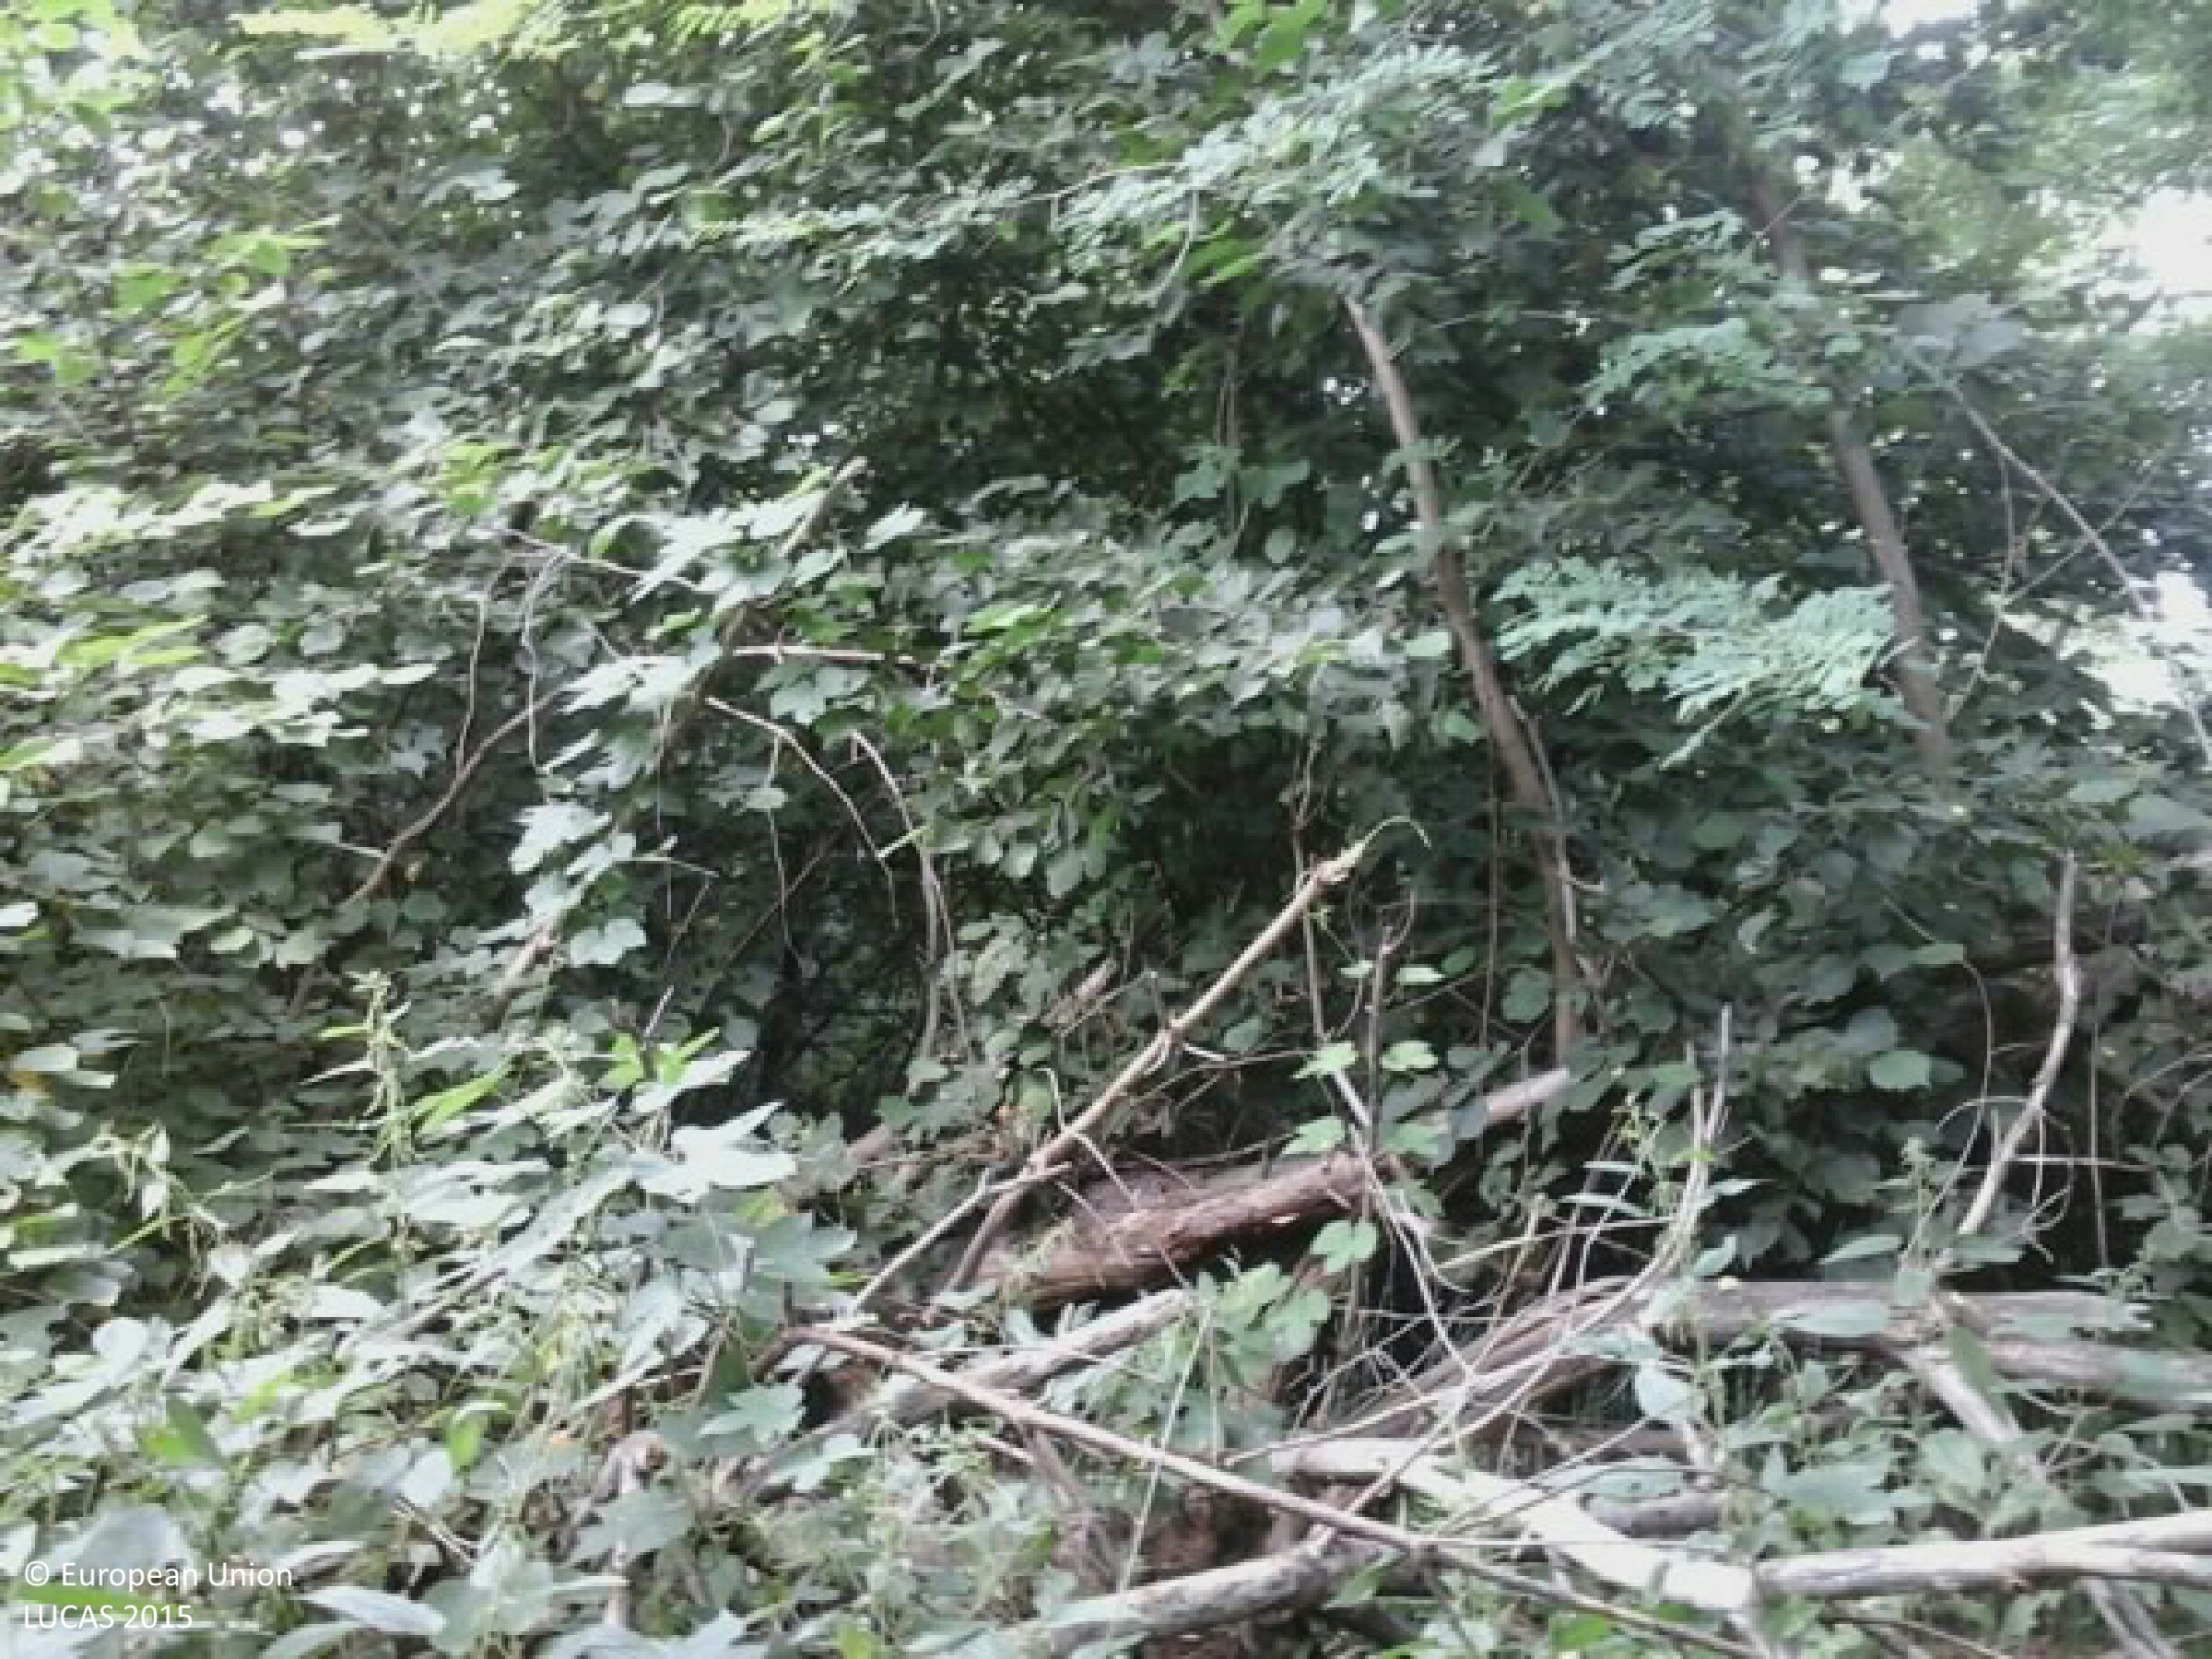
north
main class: Woodland
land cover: Broadleaved woodland
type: exotic forest
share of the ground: > 75 %
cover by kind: broadleaved forest trees 90 %, shrubs 5 %, herbaceous plants 5 %
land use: Forestry
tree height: > 5 m
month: July
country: HU
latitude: 46.4689
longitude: 16.9437
